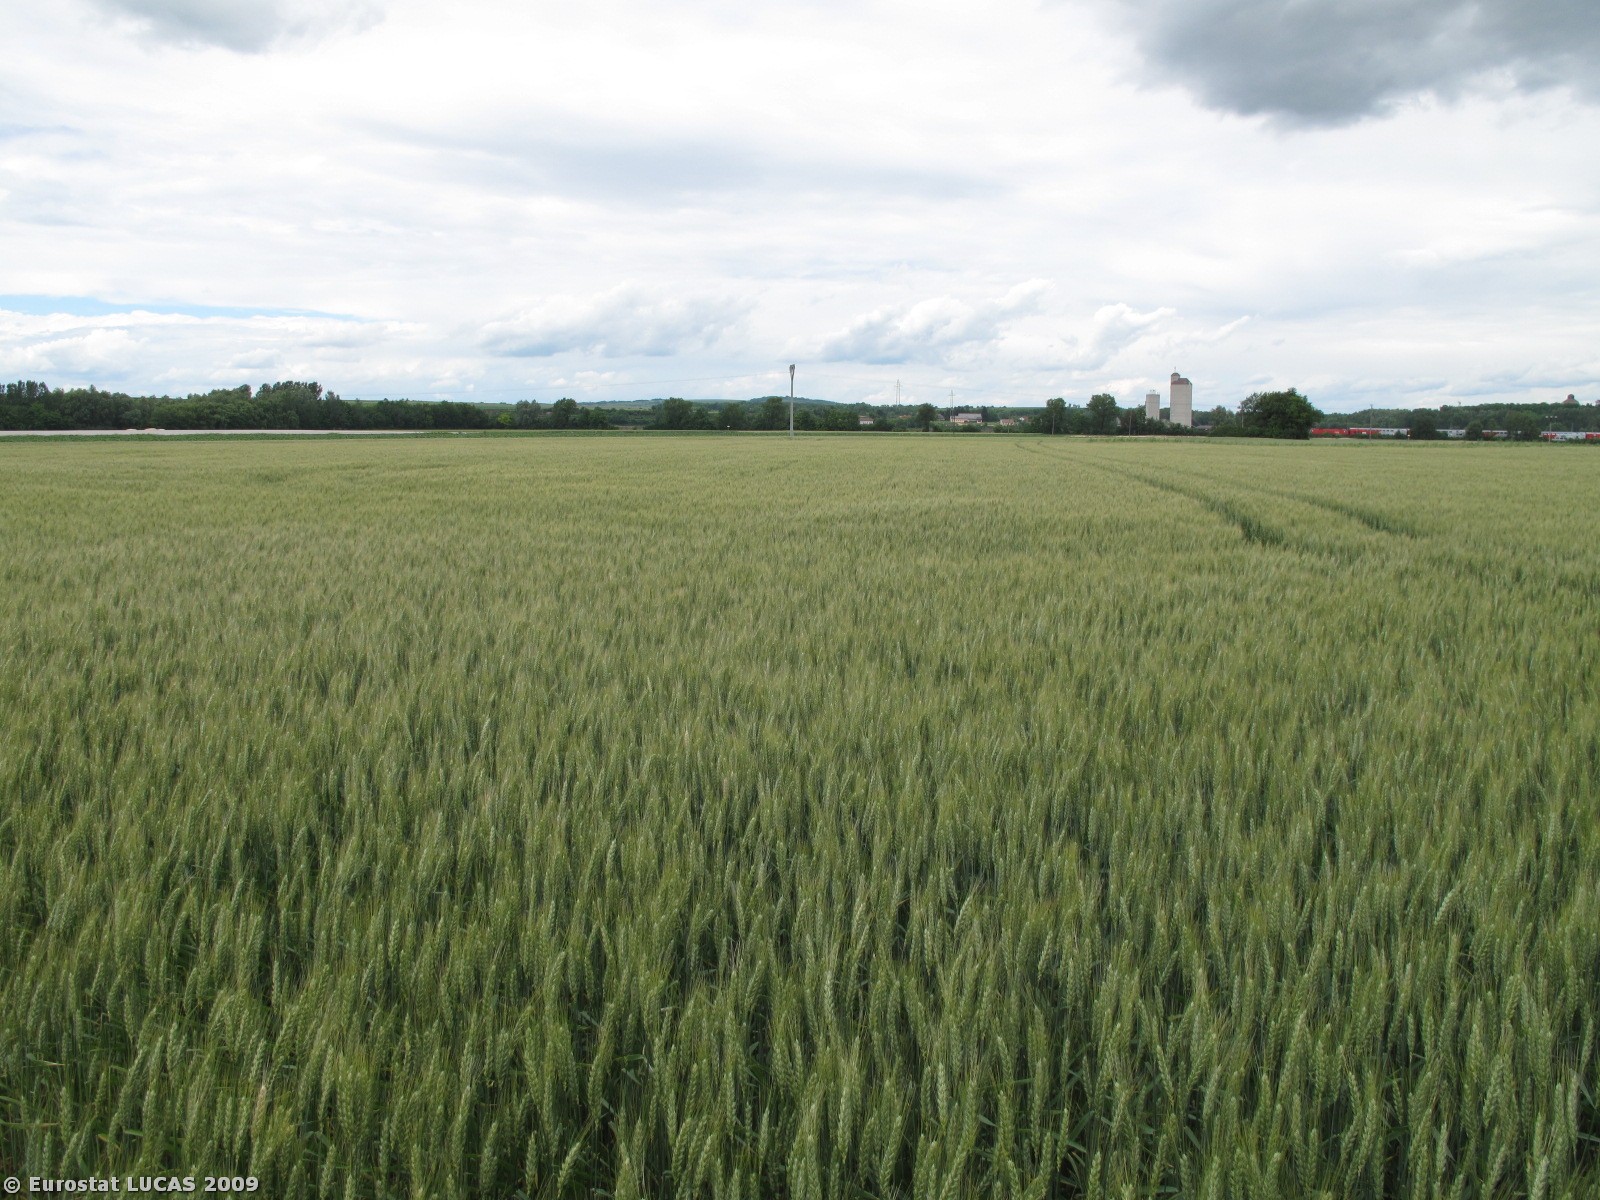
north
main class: Cropland
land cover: Common wheat
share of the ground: > 75 %
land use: Agriculture (excluding fallow land and kitchen gardens)
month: June
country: AT
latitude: 48.4050
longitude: 15.9612
